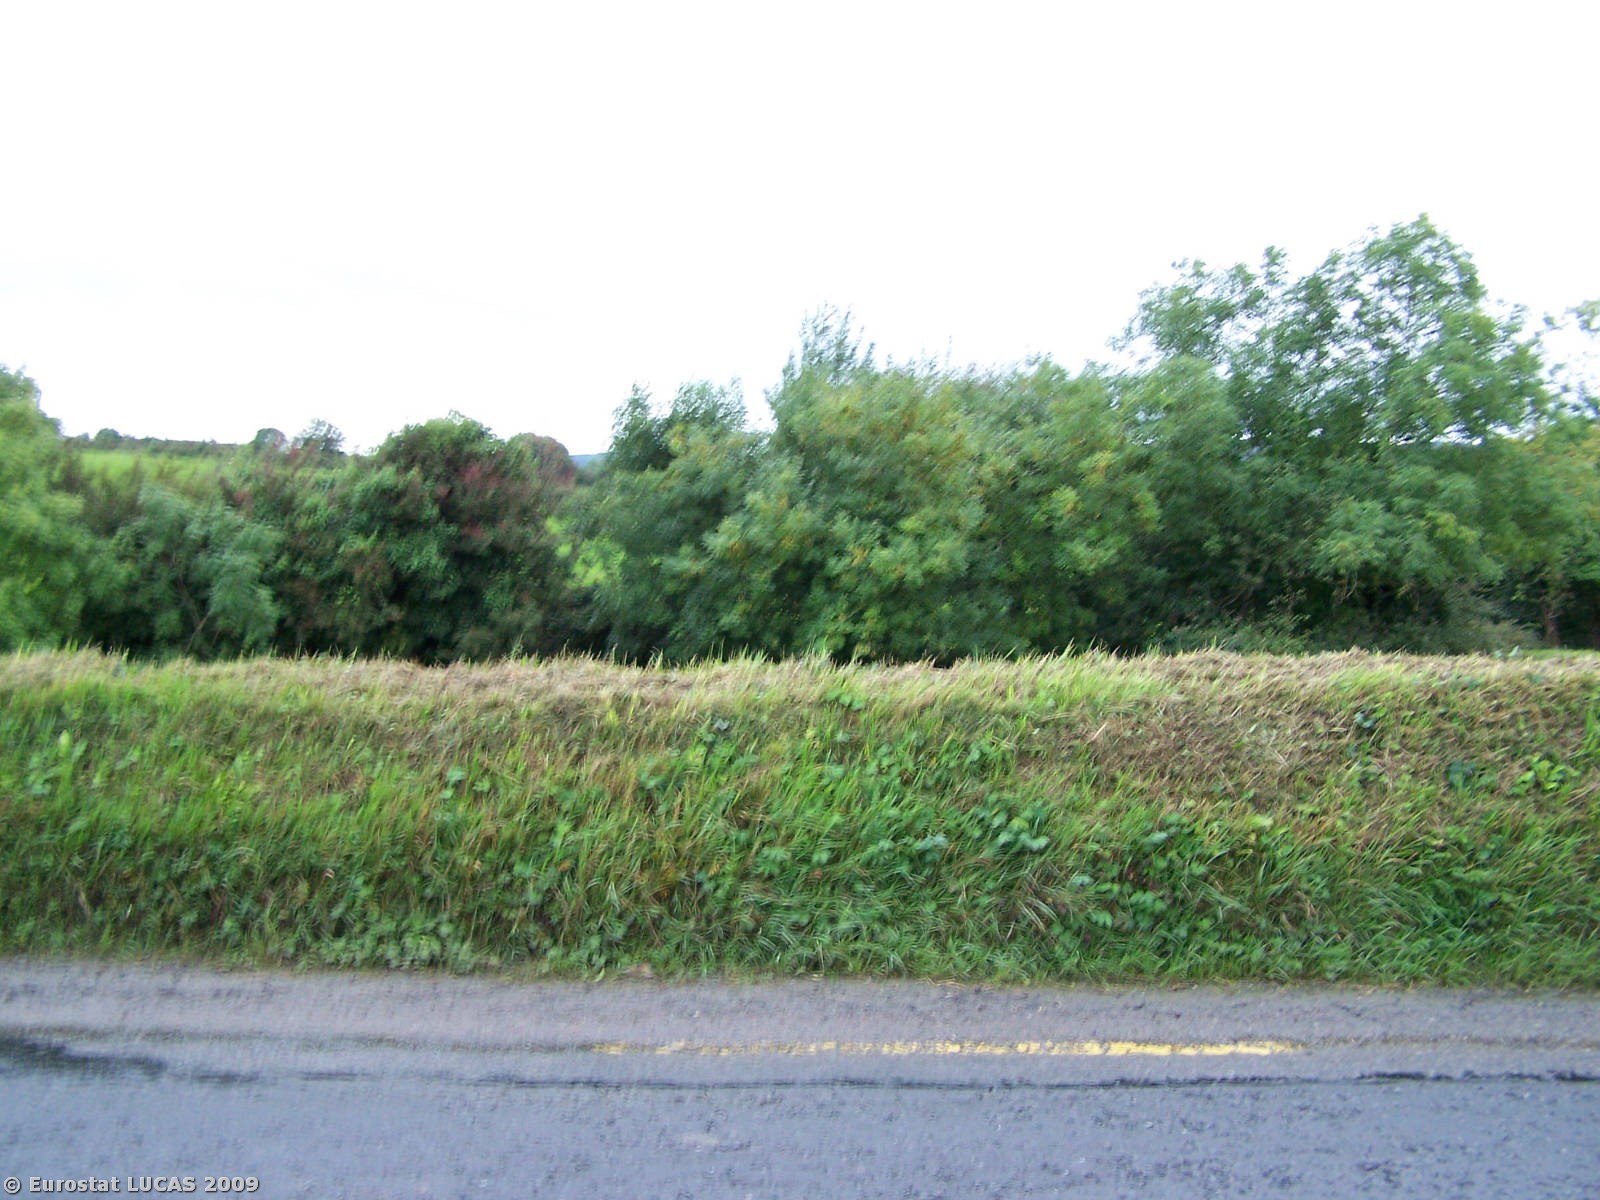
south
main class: Grassland
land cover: Grassland without tree/shrub cover
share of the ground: > 75 %
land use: Agriculture (excluding fallow land and kitchen gardens)
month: September
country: IE
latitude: 52.2841
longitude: -9.6630
